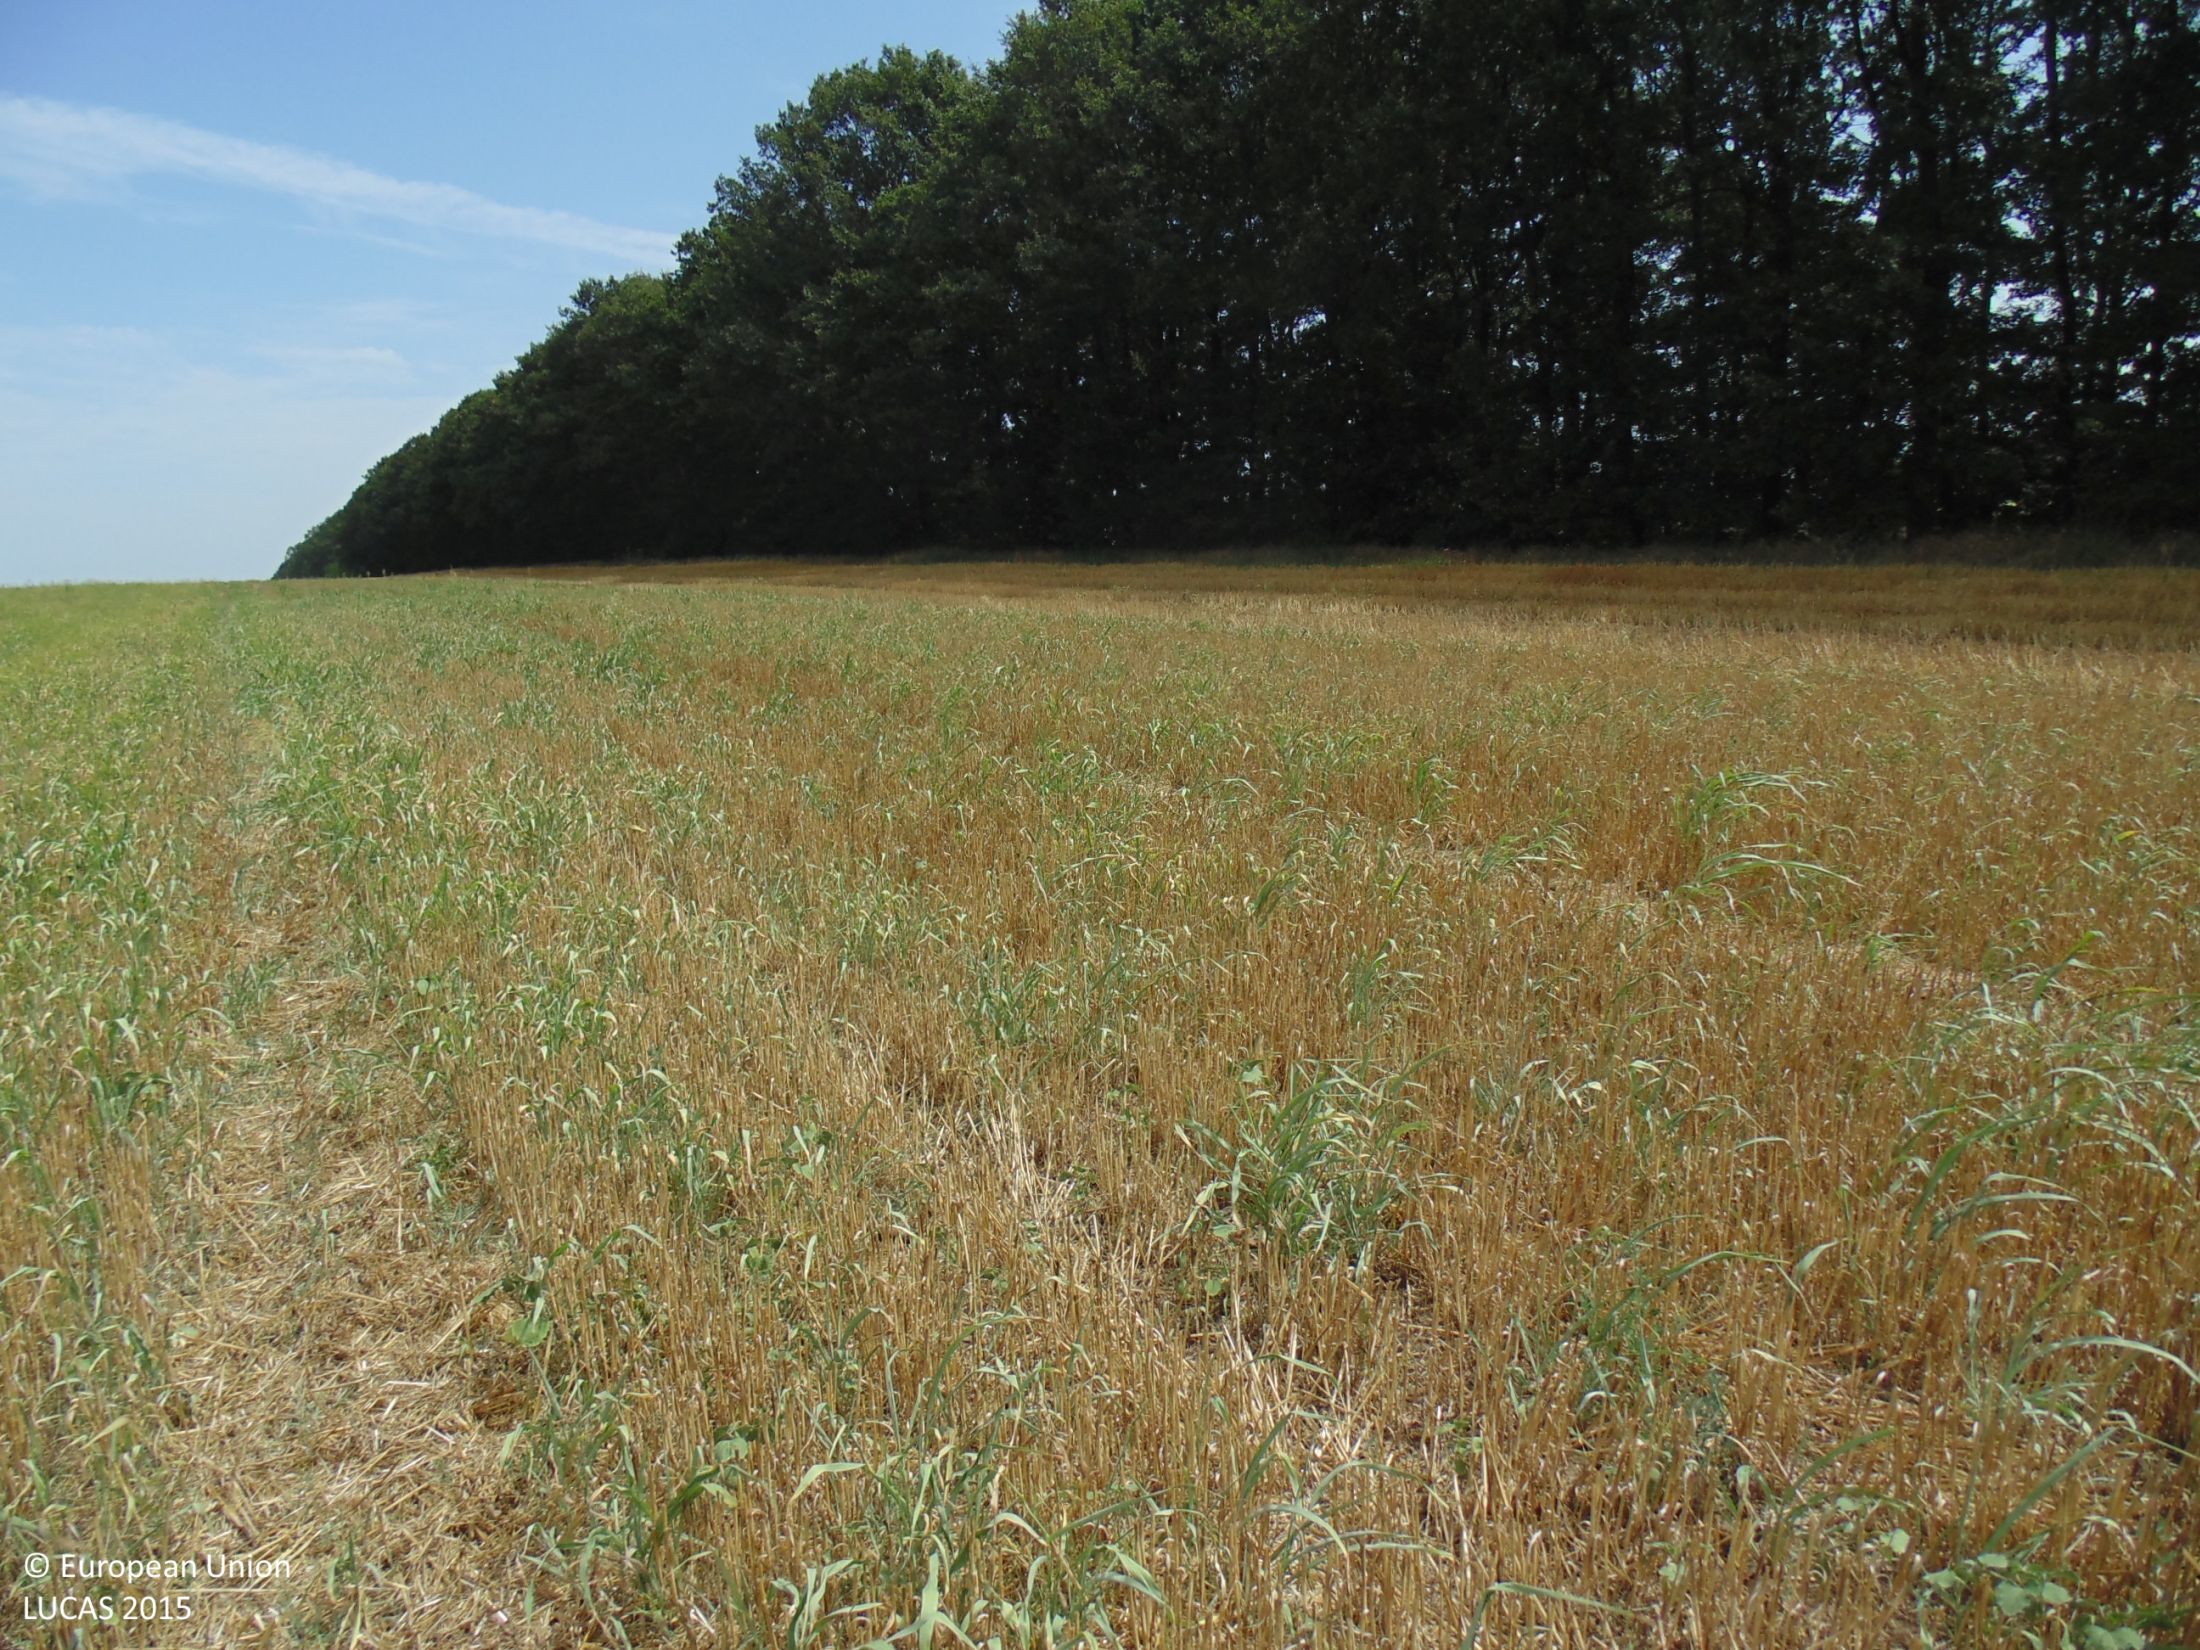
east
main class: Cropland
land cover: Common wheat
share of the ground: 50 - 75 %
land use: Agriculture (excluding fallow land and kitchen gardens)
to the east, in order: Common wheat; Grass margins; Broadleaved woodland; Tracks; Broadleaved woodland; Grass margins; Common wheat
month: August
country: BG
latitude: 43.6048
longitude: 28.2294
